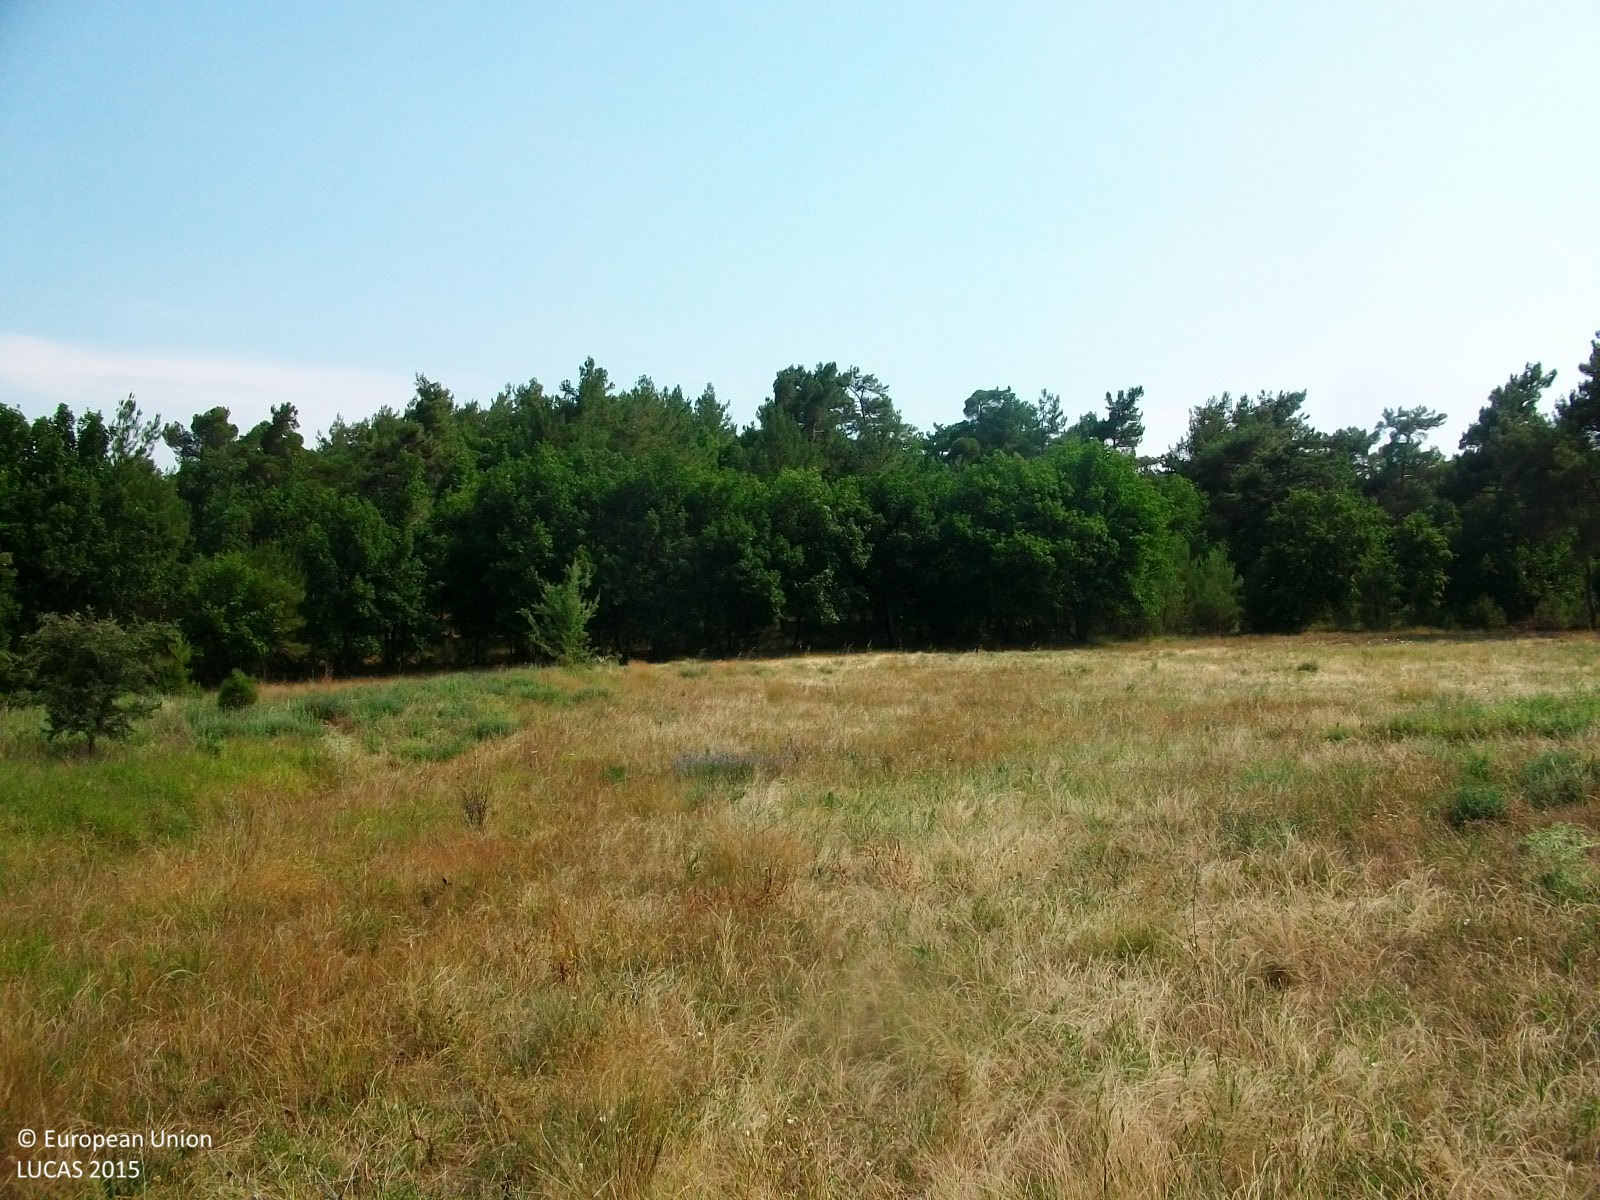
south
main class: Grassland
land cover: Spontaneously vegetated surfaces
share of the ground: > 75 %
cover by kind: herbaceous plants 100 %
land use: Fallow land
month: July
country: GR
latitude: 41.1359
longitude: 26.2092
